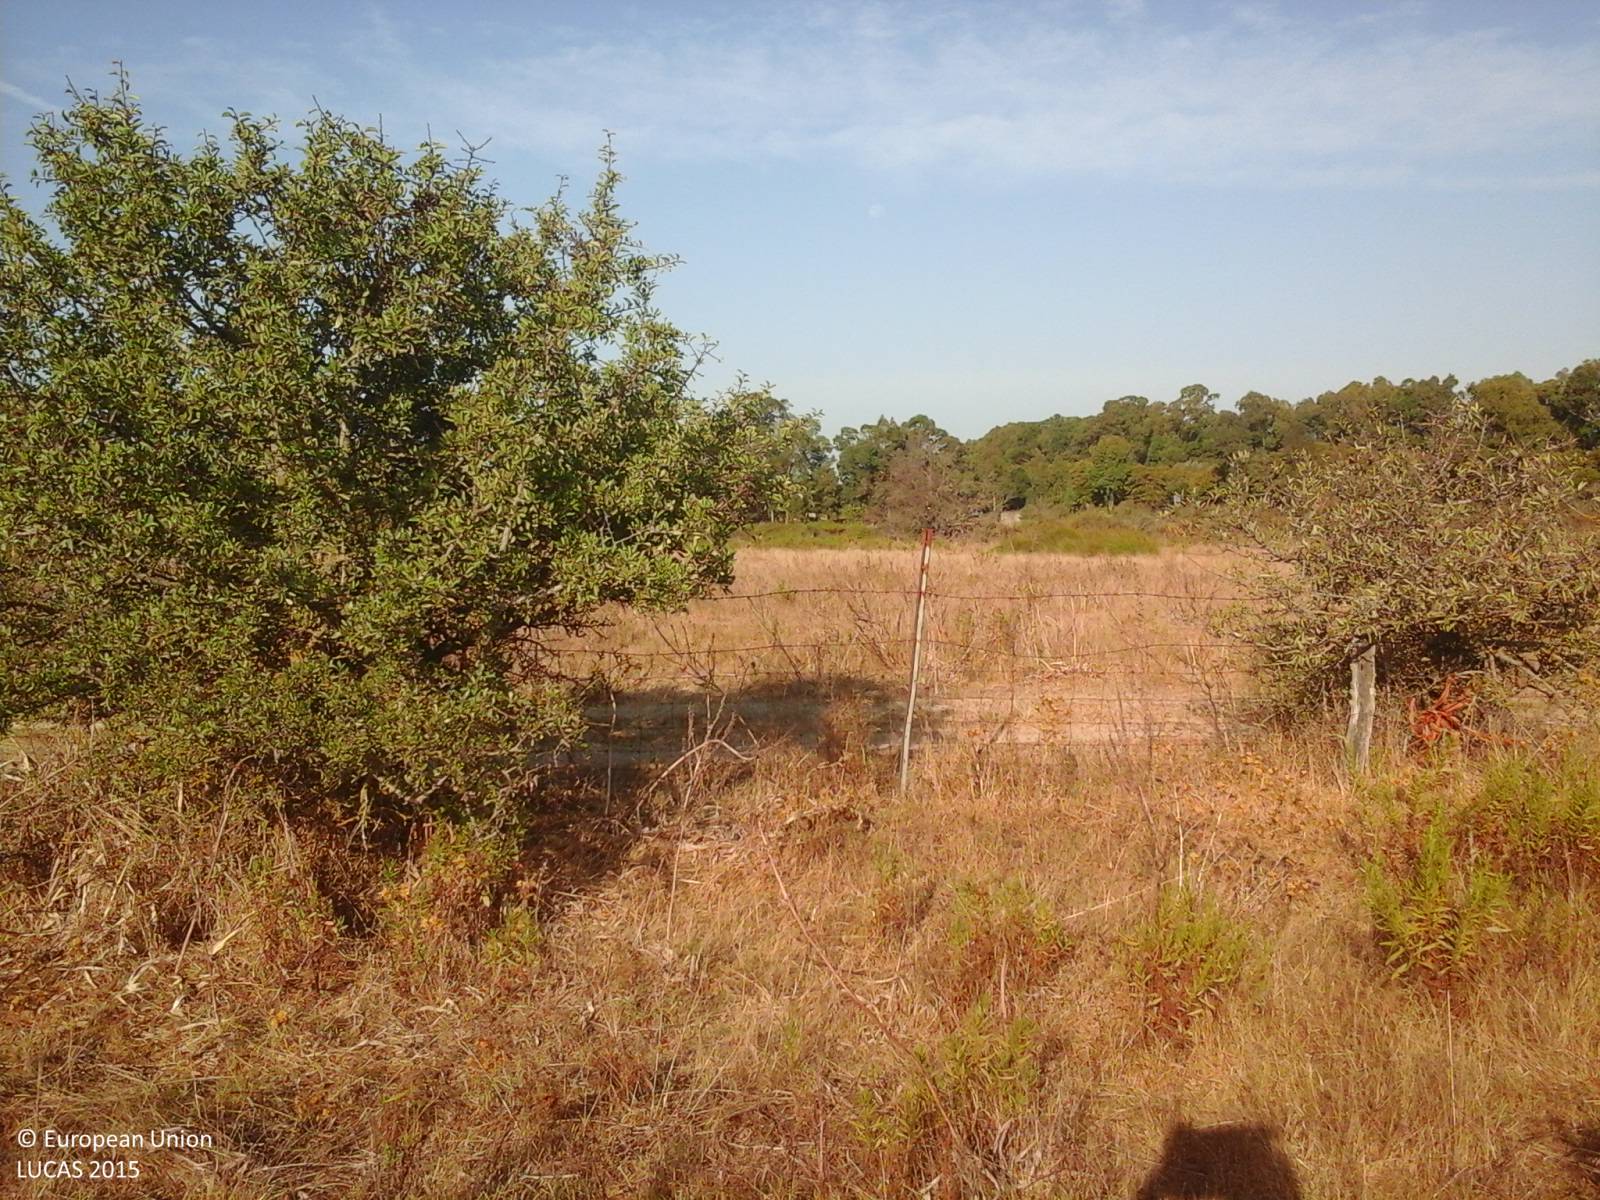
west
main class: Grassland
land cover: Grassland without tree/shrub cover
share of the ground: > 75 %
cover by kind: herbaceous plants 95 %, shrubs 5 %
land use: Agriculture (excluding fallow land and kitchen gardens)
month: September
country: IT
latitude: 41.0618
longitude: 9.4196
